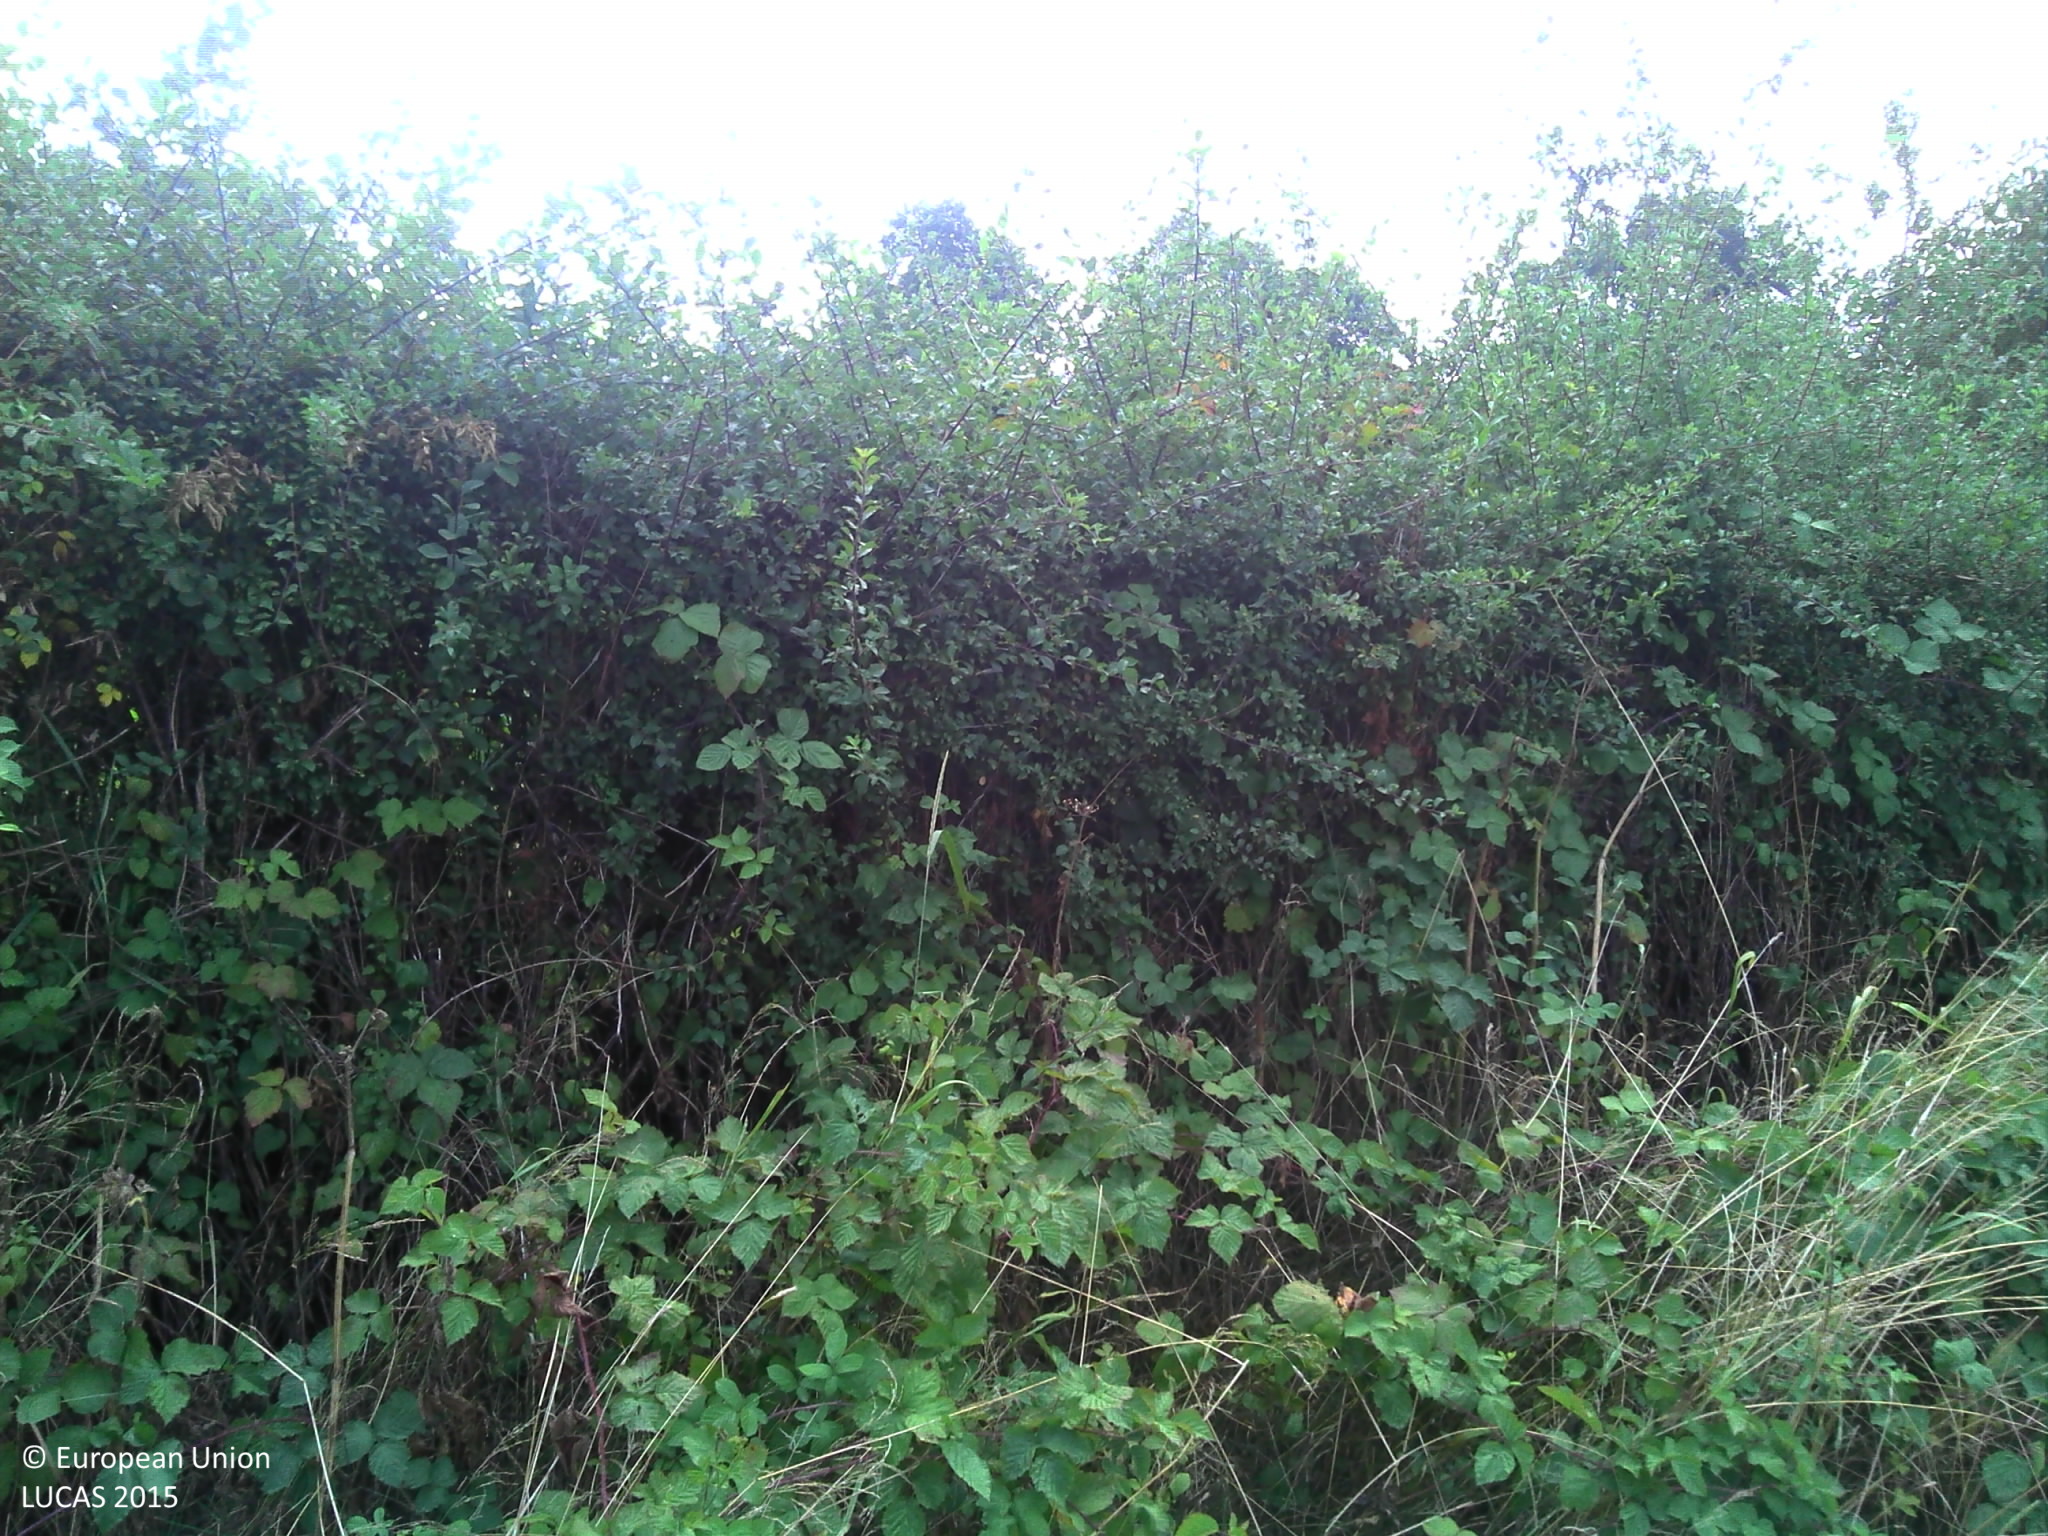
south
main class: Grassland
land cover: Grassland without tree/shrub cover
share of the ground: > 75 %
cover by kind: herbaceous plants 100 %
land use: Agriculture (excluding fallow land and kitchen gardens)
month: August
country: FR
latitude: 46.3055
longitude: 3.6246
